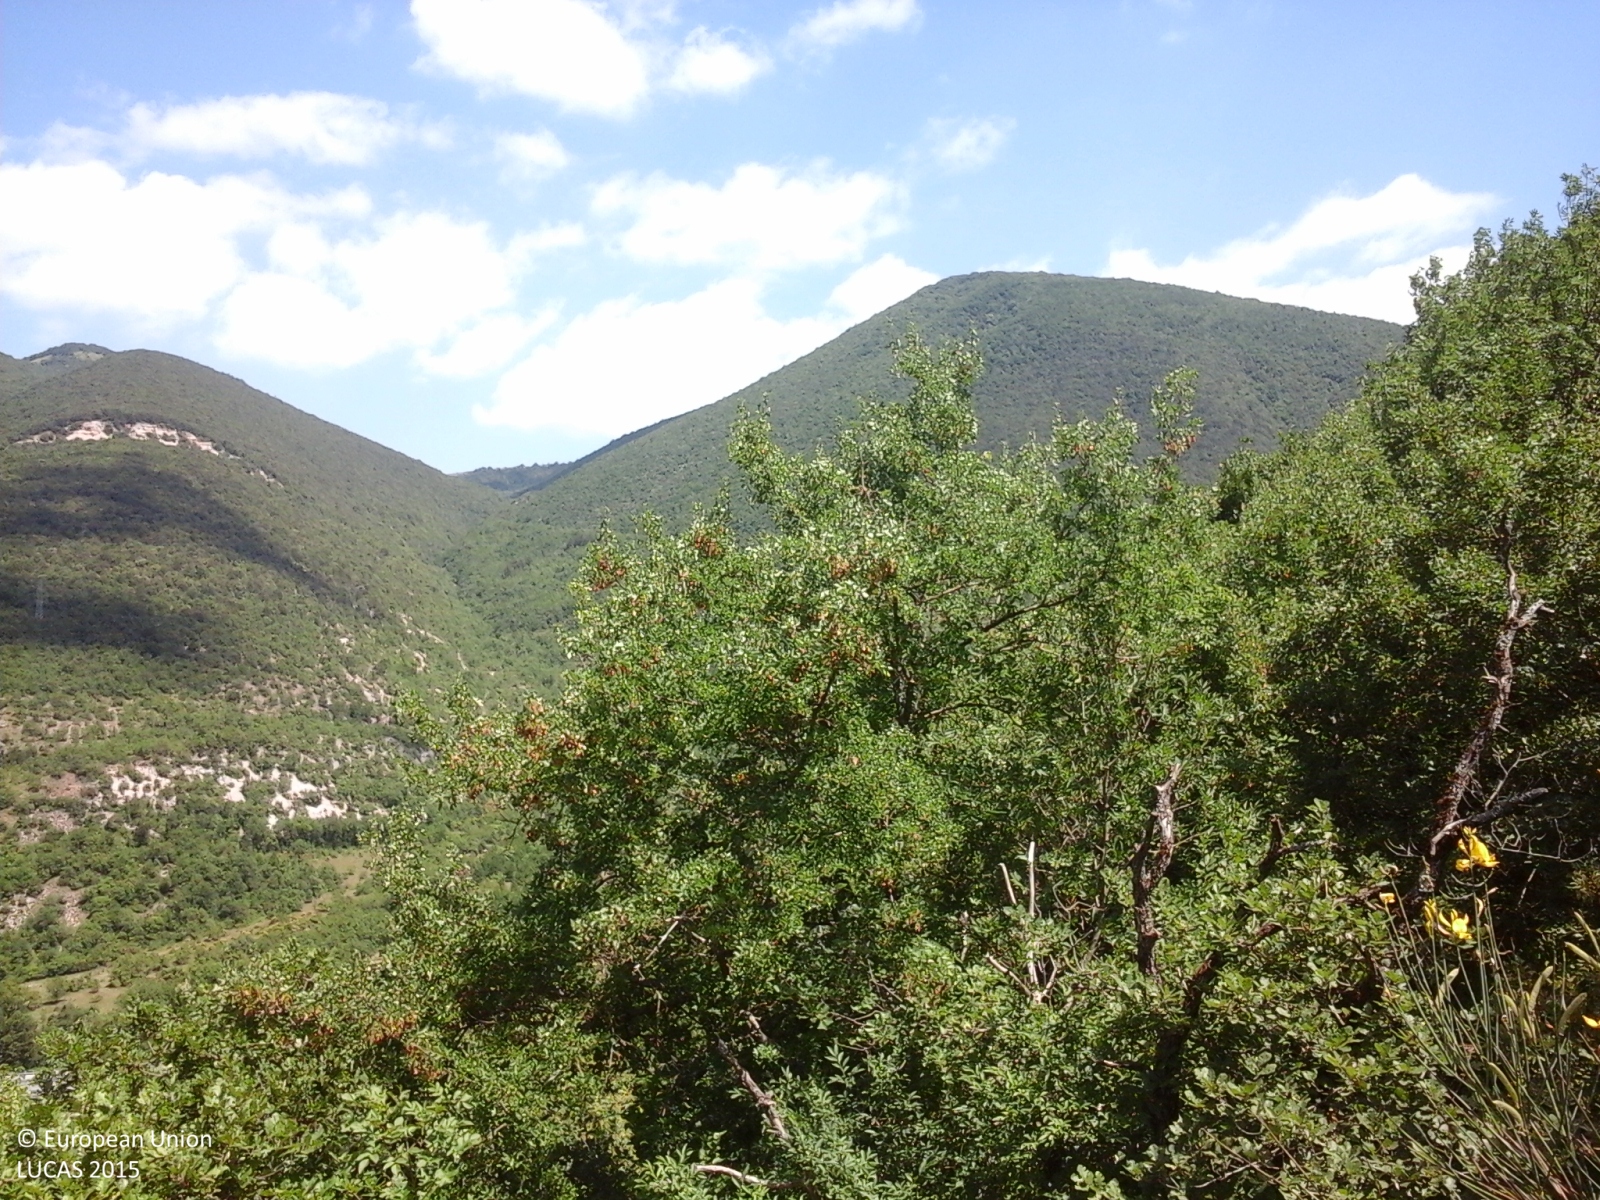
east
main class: Woodland
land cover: Broadleaved woodland
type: thermophilous deciduous forest
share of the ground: > 75 %
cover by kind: broadleaved forest trees 95 %, herbaceous plants 5 %
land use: Forestry
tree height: < 5 m
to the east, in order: Broadleaved woodland; Electric lines; Broadleaved woodland; Tracks; Abandoned hedges; Grass margins; Paved roads, cycling and walking lanes; Abandoned hedges; Lucerne; Electric lines; Lucerne; Sunflower
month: June
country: IT
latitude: 43.1118
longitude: 13.1251
